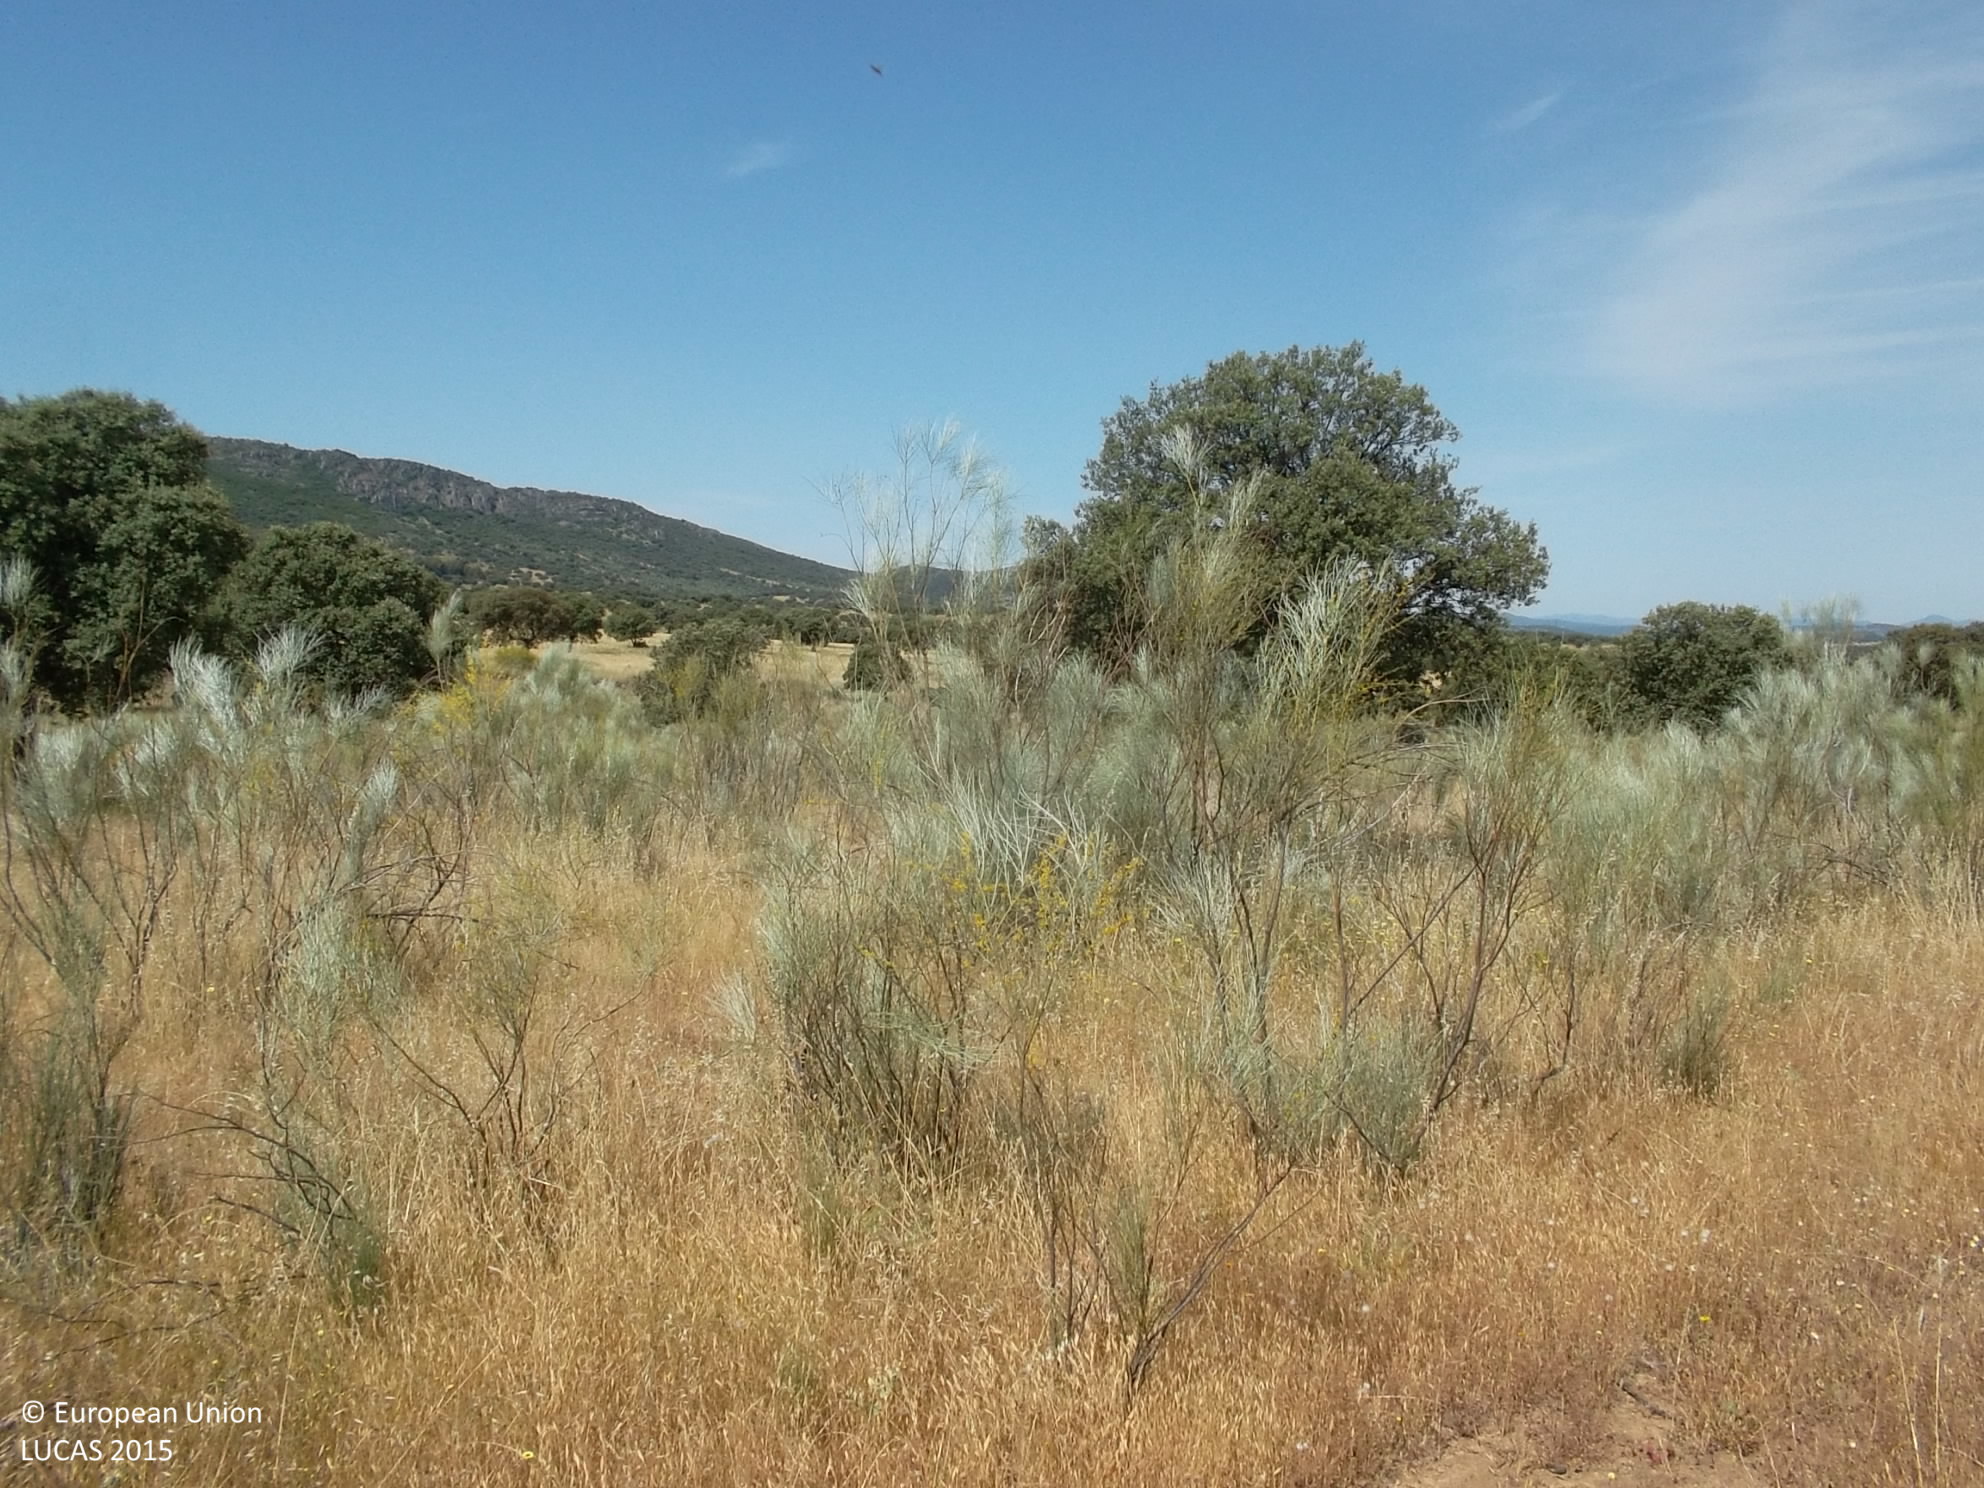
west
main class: Woodland
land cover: Broadleaved woodland
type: broadleaved evergreen forest
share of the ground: 10 - 25 %
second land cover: Shrubland without tree cover
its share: 50 - 75 %
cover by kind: herbaceous plants 55 %, shrubs 30 %, broadleaved forest trees 15 %
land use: Forestry
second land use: Agriculture (excluding fallow land and kitchen gardens)
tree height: > 5 m
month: May
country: ES
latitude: 38.6539
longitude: -4.7229
